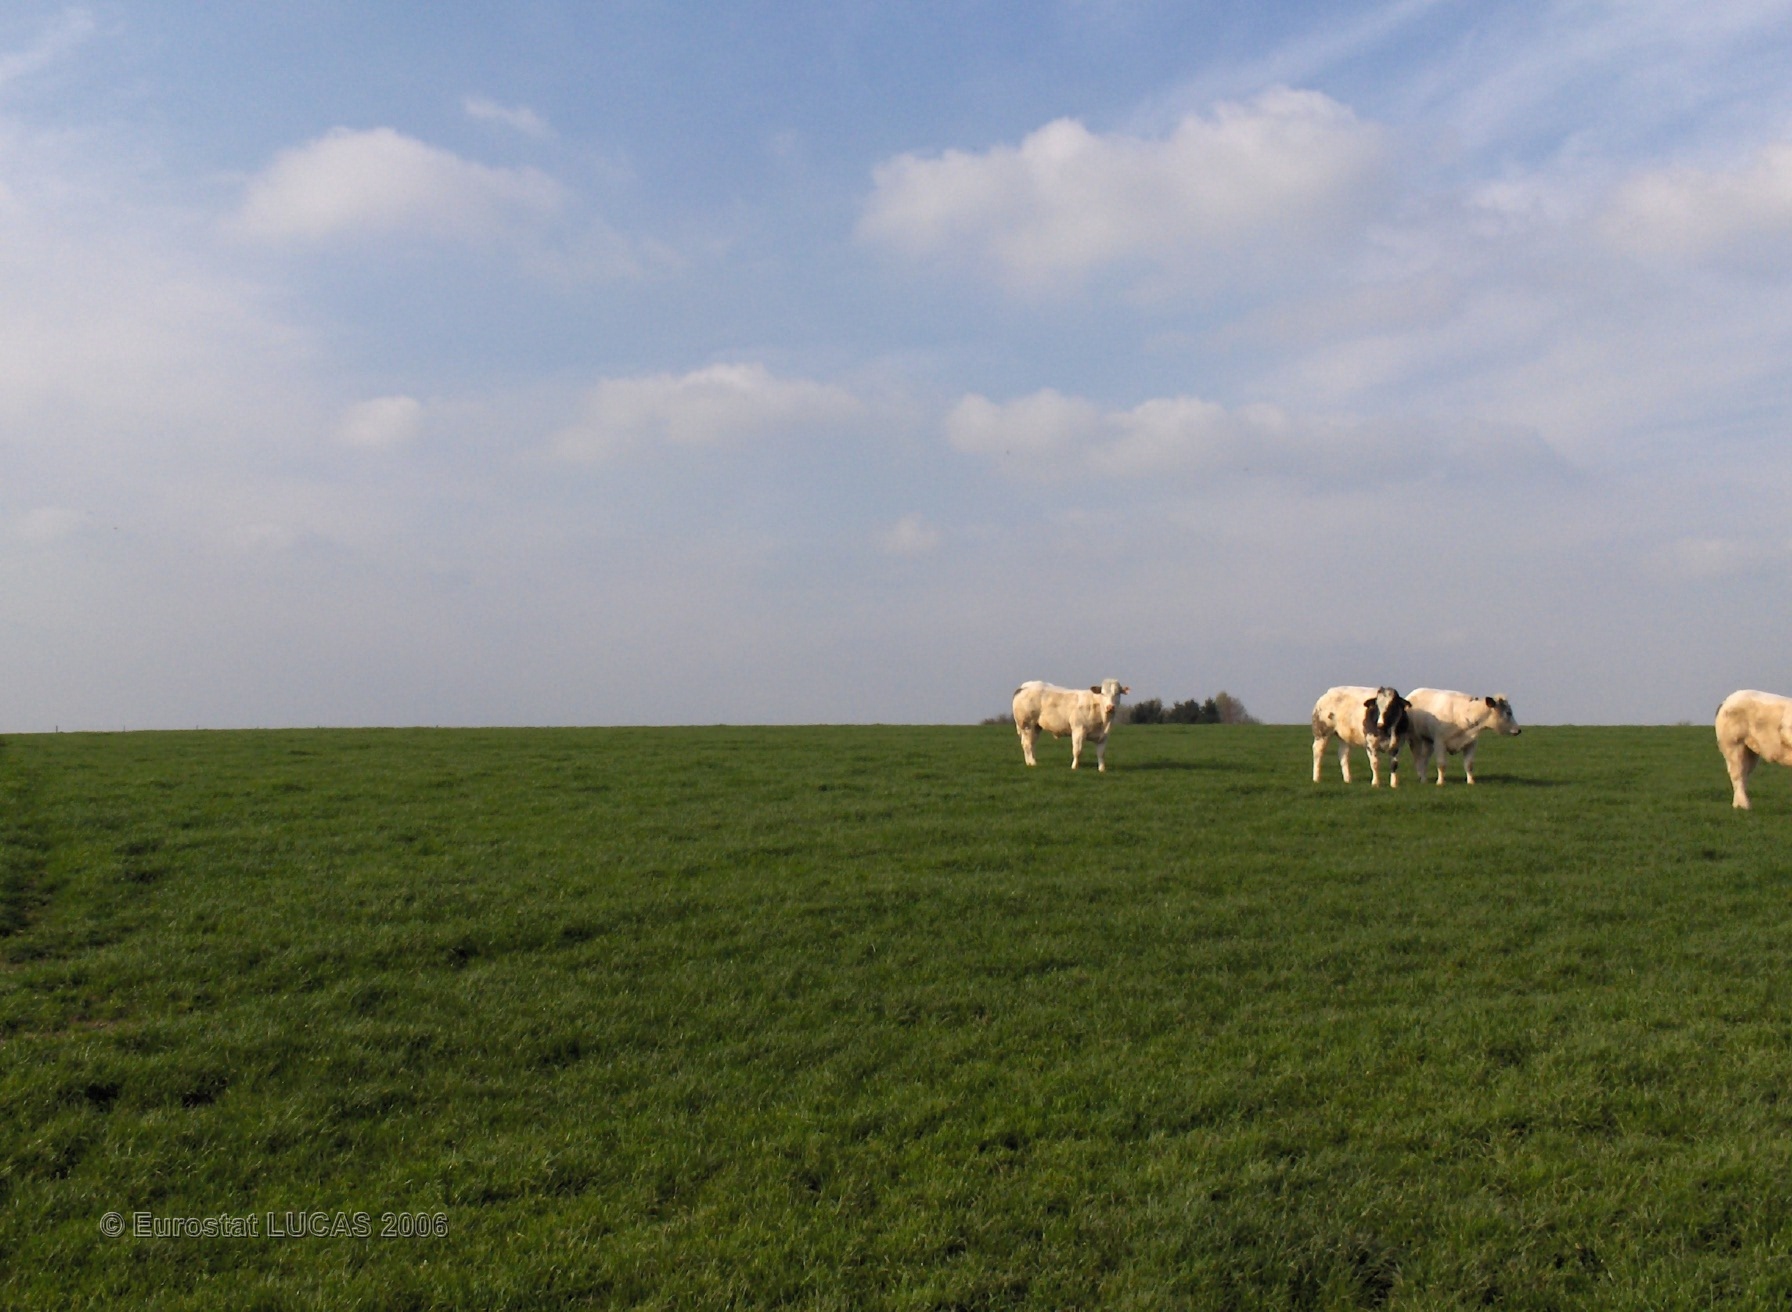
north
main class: Grassland
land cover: Grassland without tree/shrub cover
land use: Agriculture (excluding fallow land and kitchen gardens)
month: April
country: BE
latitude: 50.2531
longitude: 4.5684
